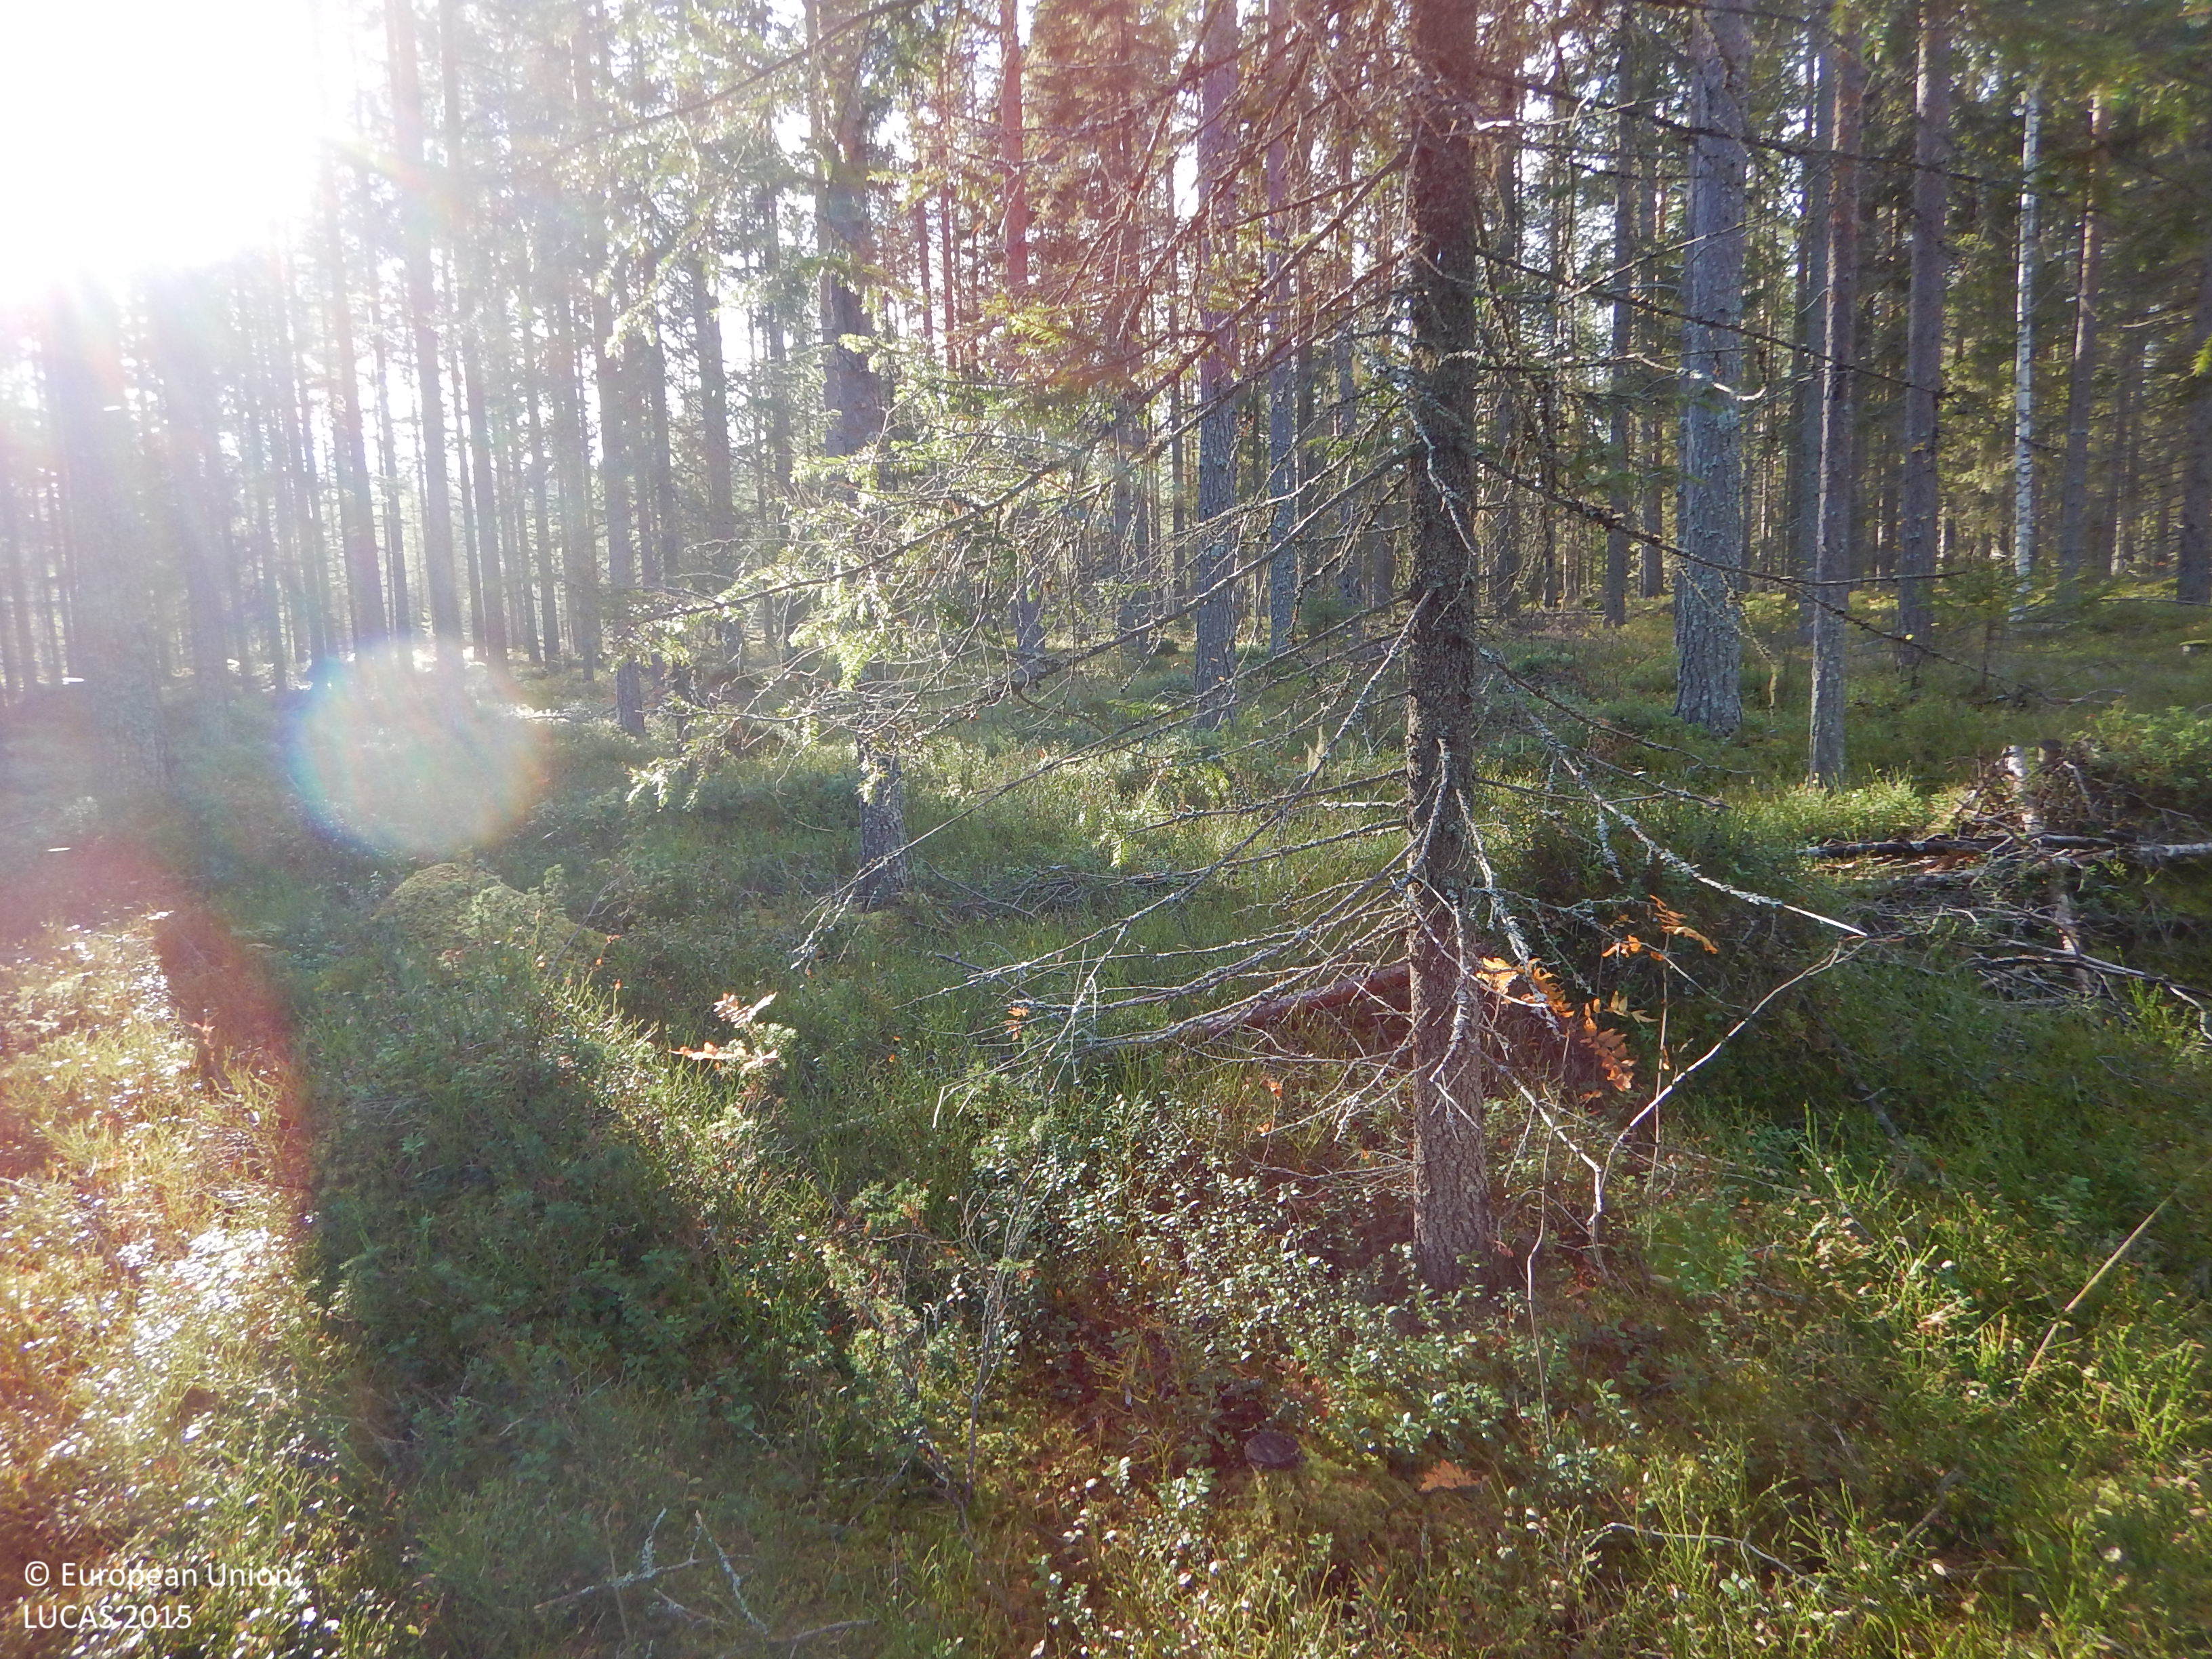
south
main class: Woodland
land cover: Other coniferous woodland
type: boreal forest
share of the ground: 50 - 75 %
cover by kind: coniferous forest trees 70 %, shrubs 15 %, lichens and mosses 10 %, herbaceous plants 5 %
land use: Forestry
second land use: Amenities, museums, leisure
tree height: > 5 m
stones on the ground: < 10 %
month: October
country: SE
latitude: 64.9672
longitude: 20.9686
